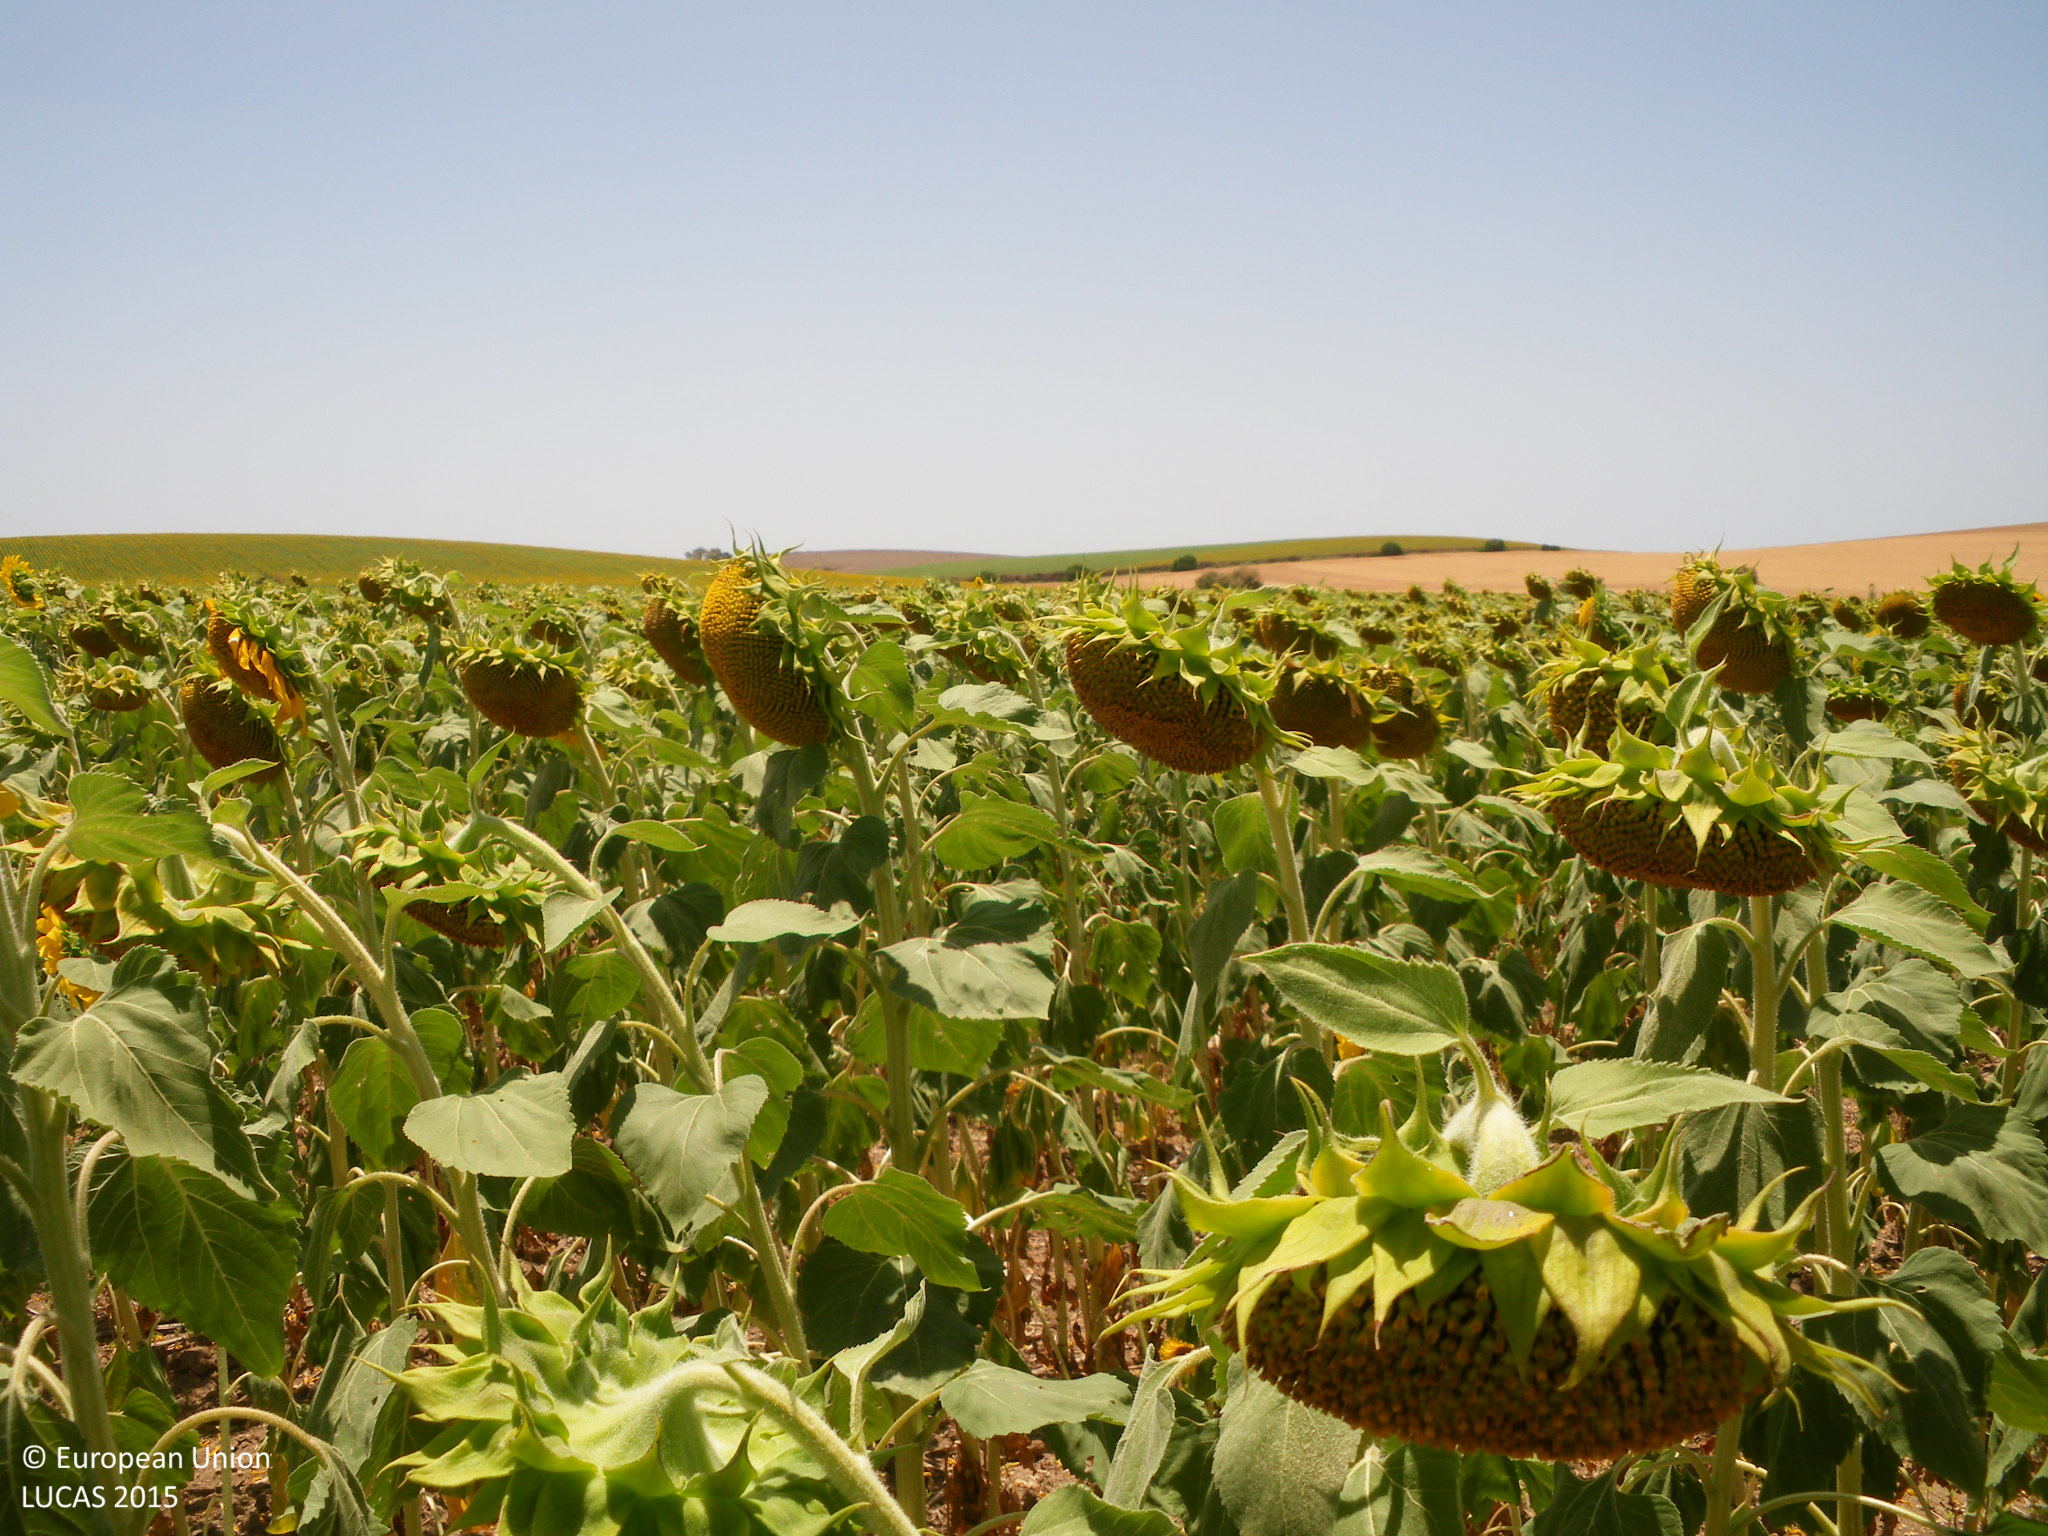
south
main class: Cropland
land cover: Sunflower
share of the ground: > 75 %
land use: Agriculture (excluding fallow land and kitchen gardens)
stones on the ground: < 10 %
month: June
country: ES
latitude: 36.8240
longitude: -6.0114
